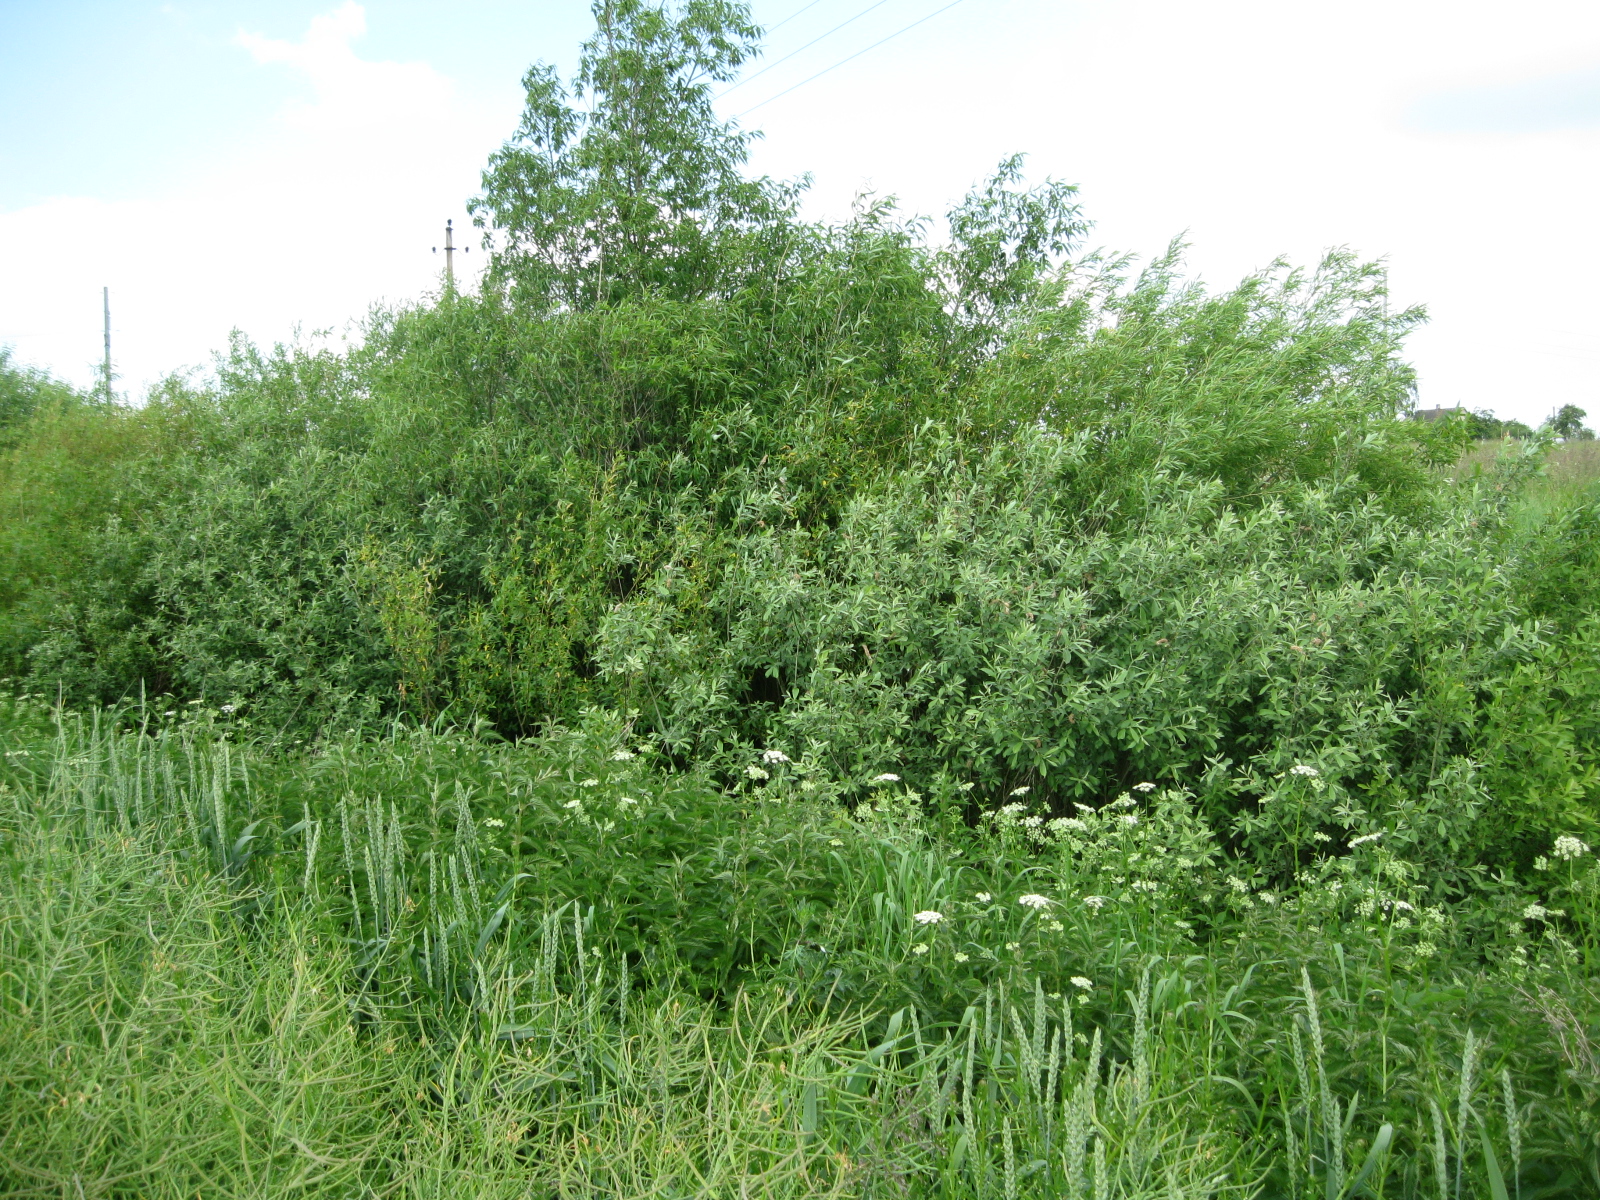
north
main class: Cropland
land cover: Rape and turnip rape
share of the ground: > 75 %
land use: Agriculture (excluding fallow land and kitchen gardens)
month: June
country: LT
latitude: 55.5371
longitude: 23.8882
